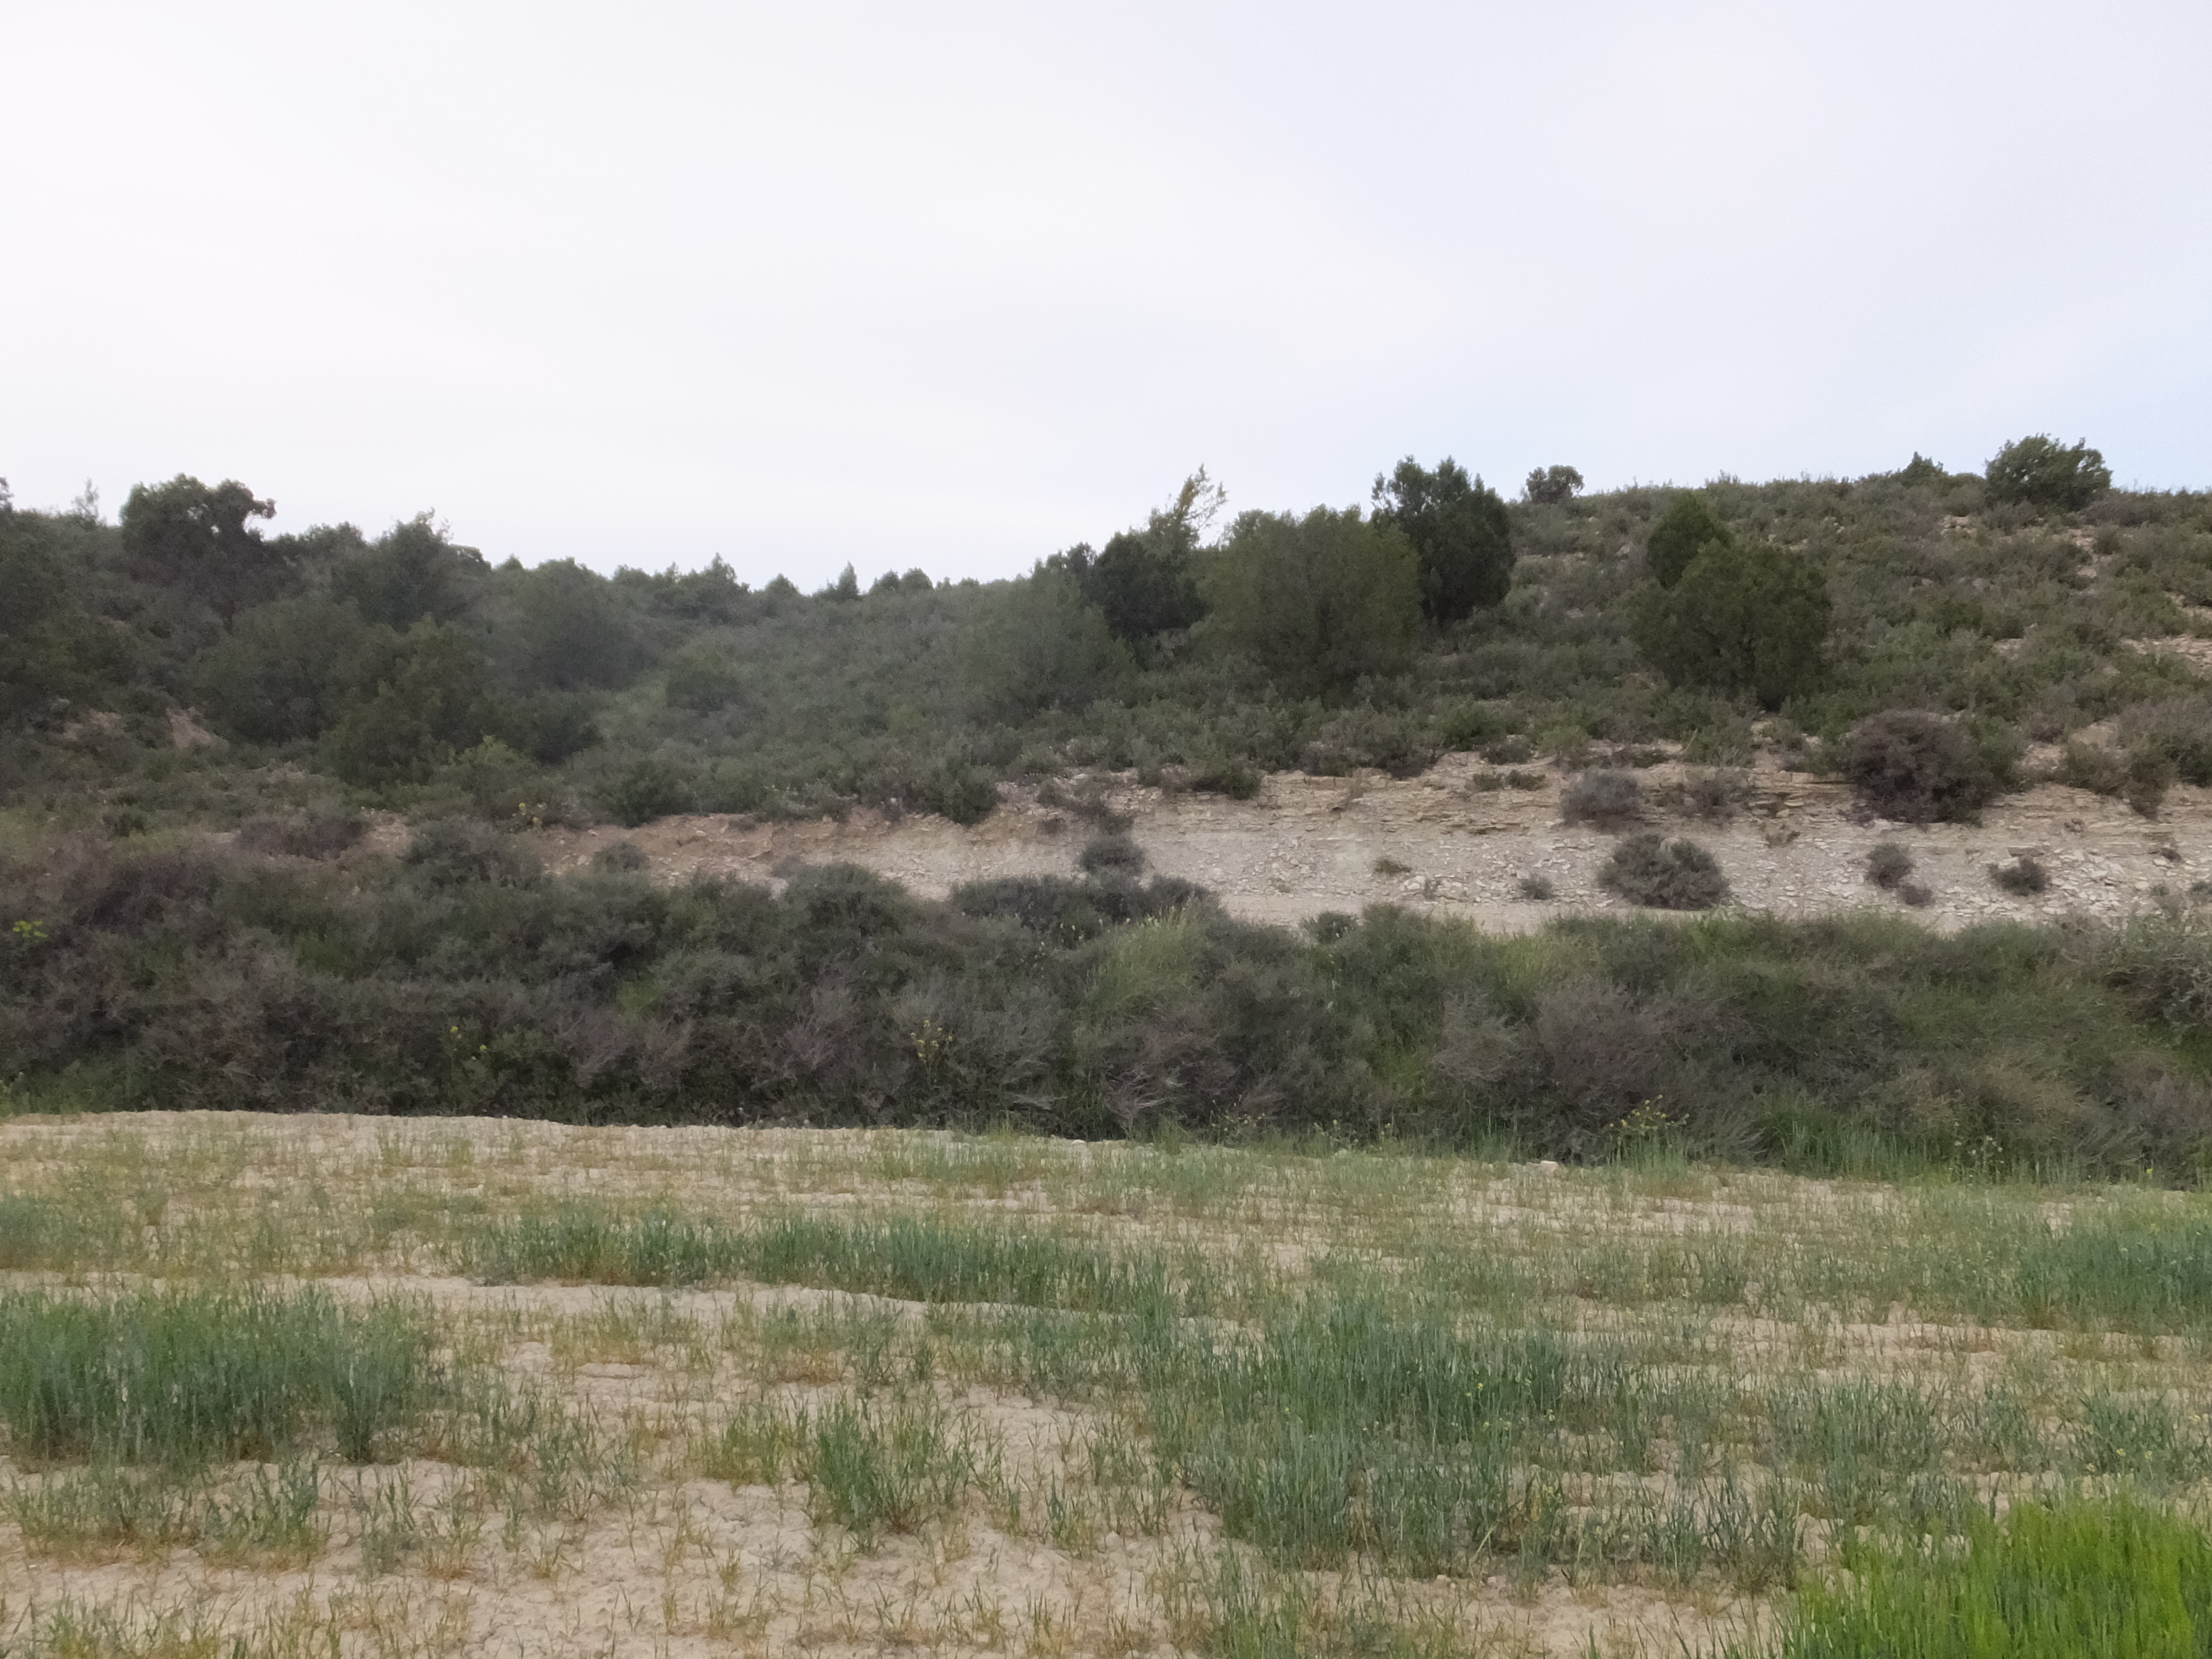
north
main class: Cropland
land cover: Barley
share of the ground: > 75 %
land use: Agriculture (excluding fallow land and kitchen gardens)
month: April
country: ES
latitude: 41.6585
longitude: -0.2610
